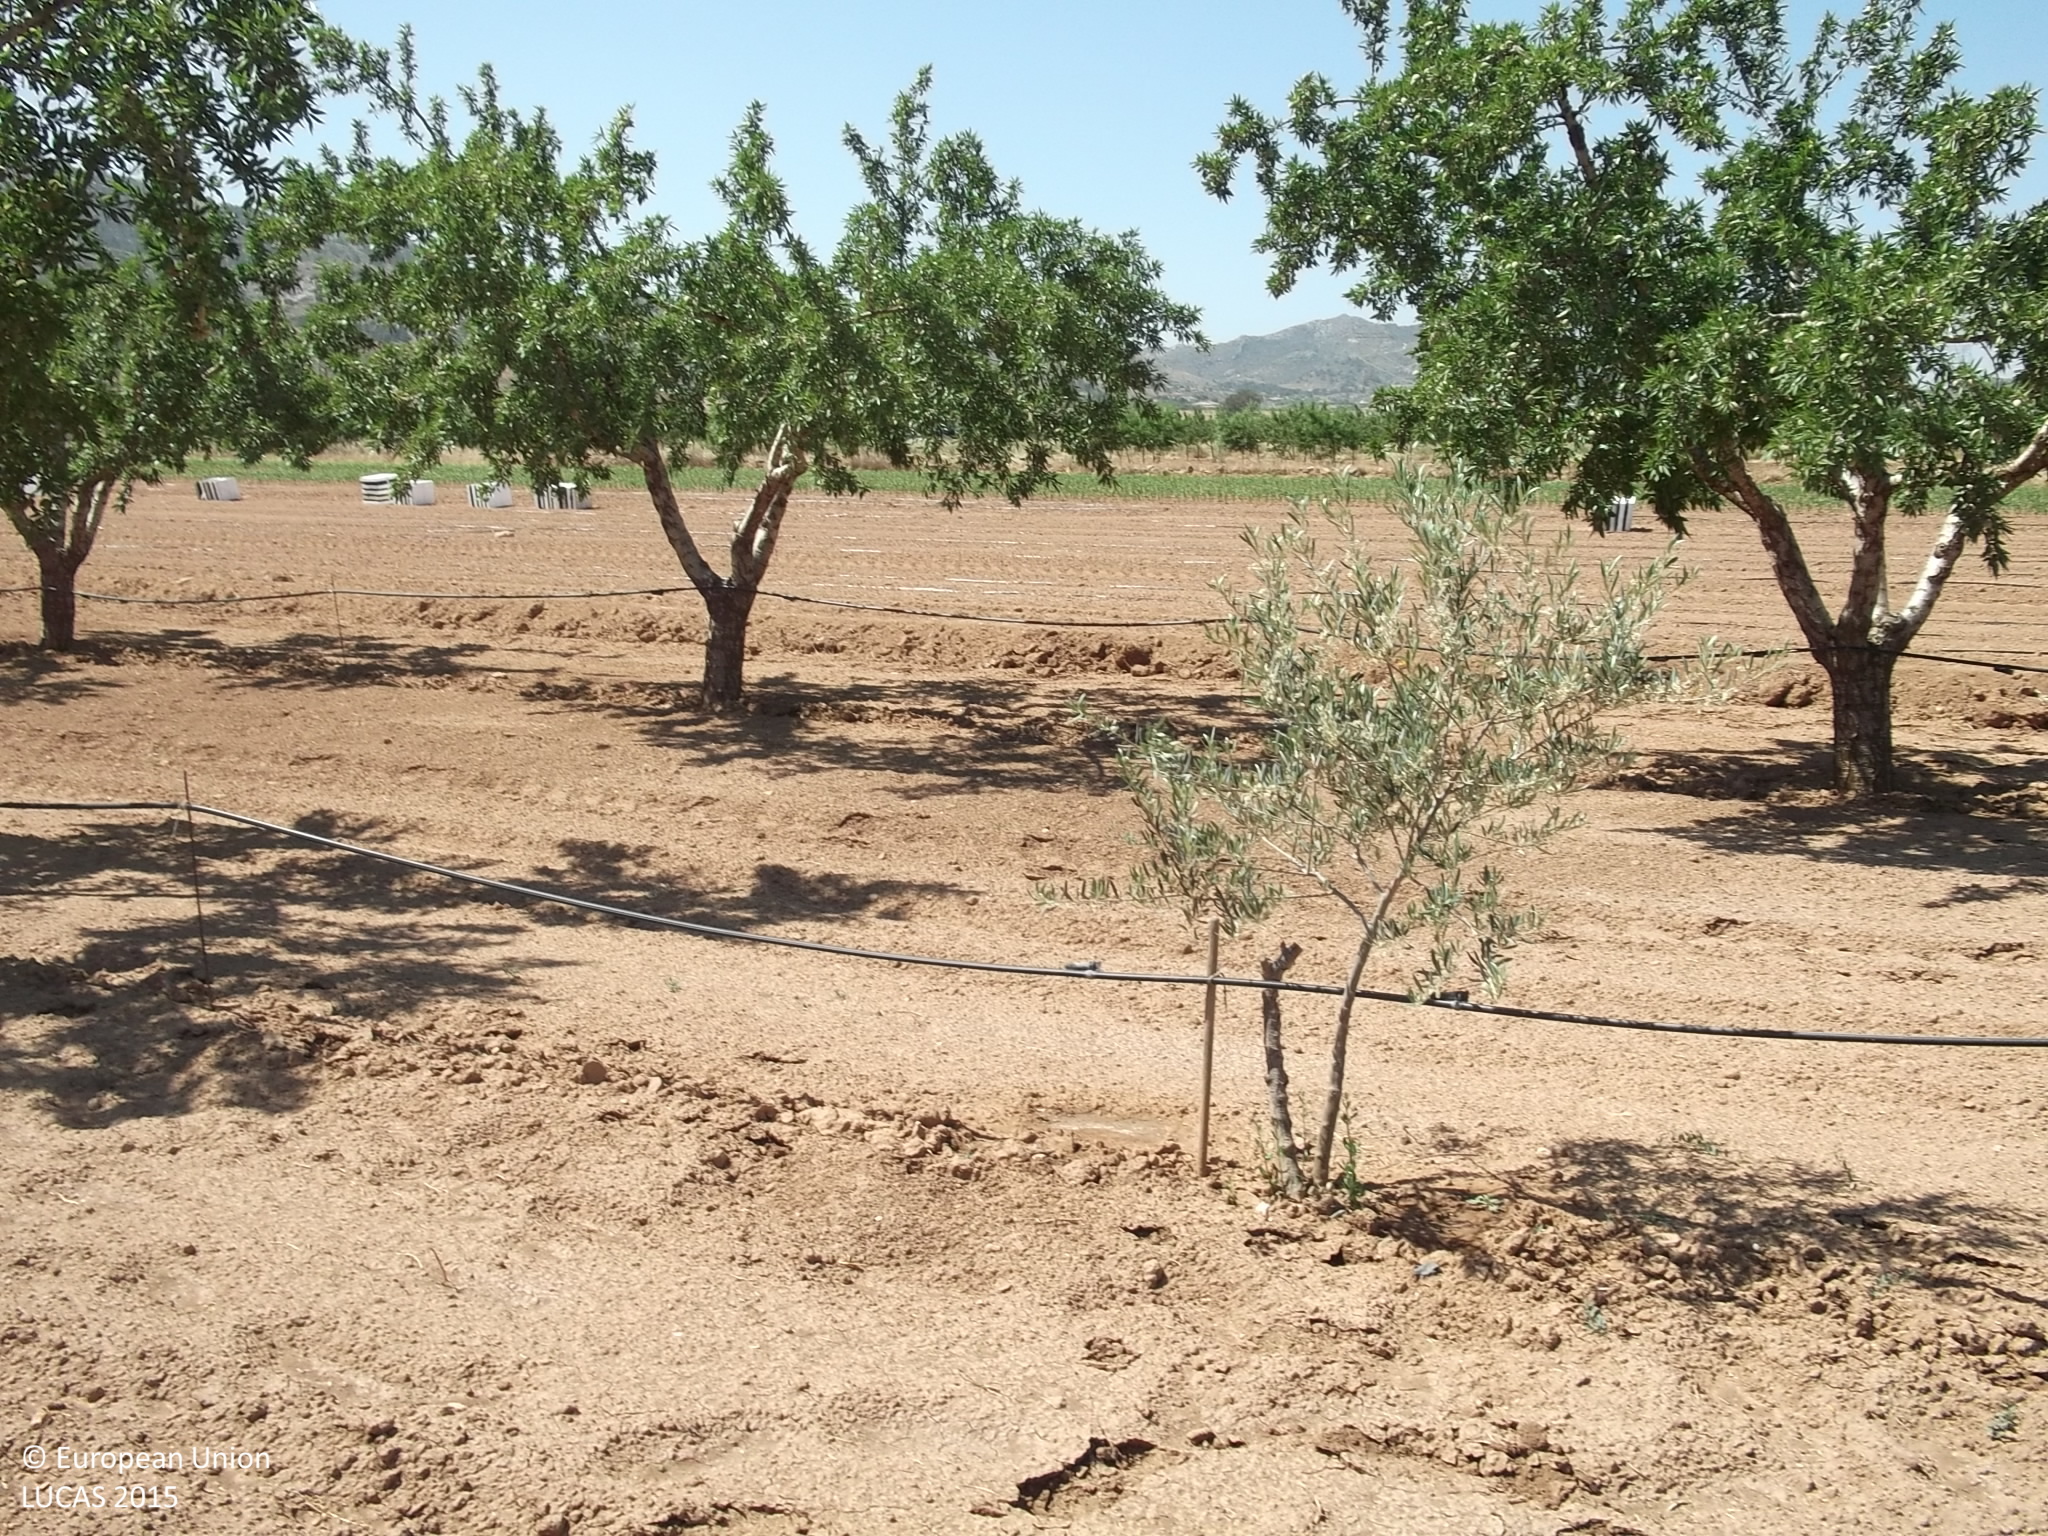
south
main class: Cropland
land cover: Nuts trees
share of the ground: 10 - 25 %
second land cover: Olive groves
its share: 10 - 25 %
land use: Agriculture (excluding fallow land and kitchen gardens)
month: May
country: ES
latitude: 38.2883
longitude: -0.9049
